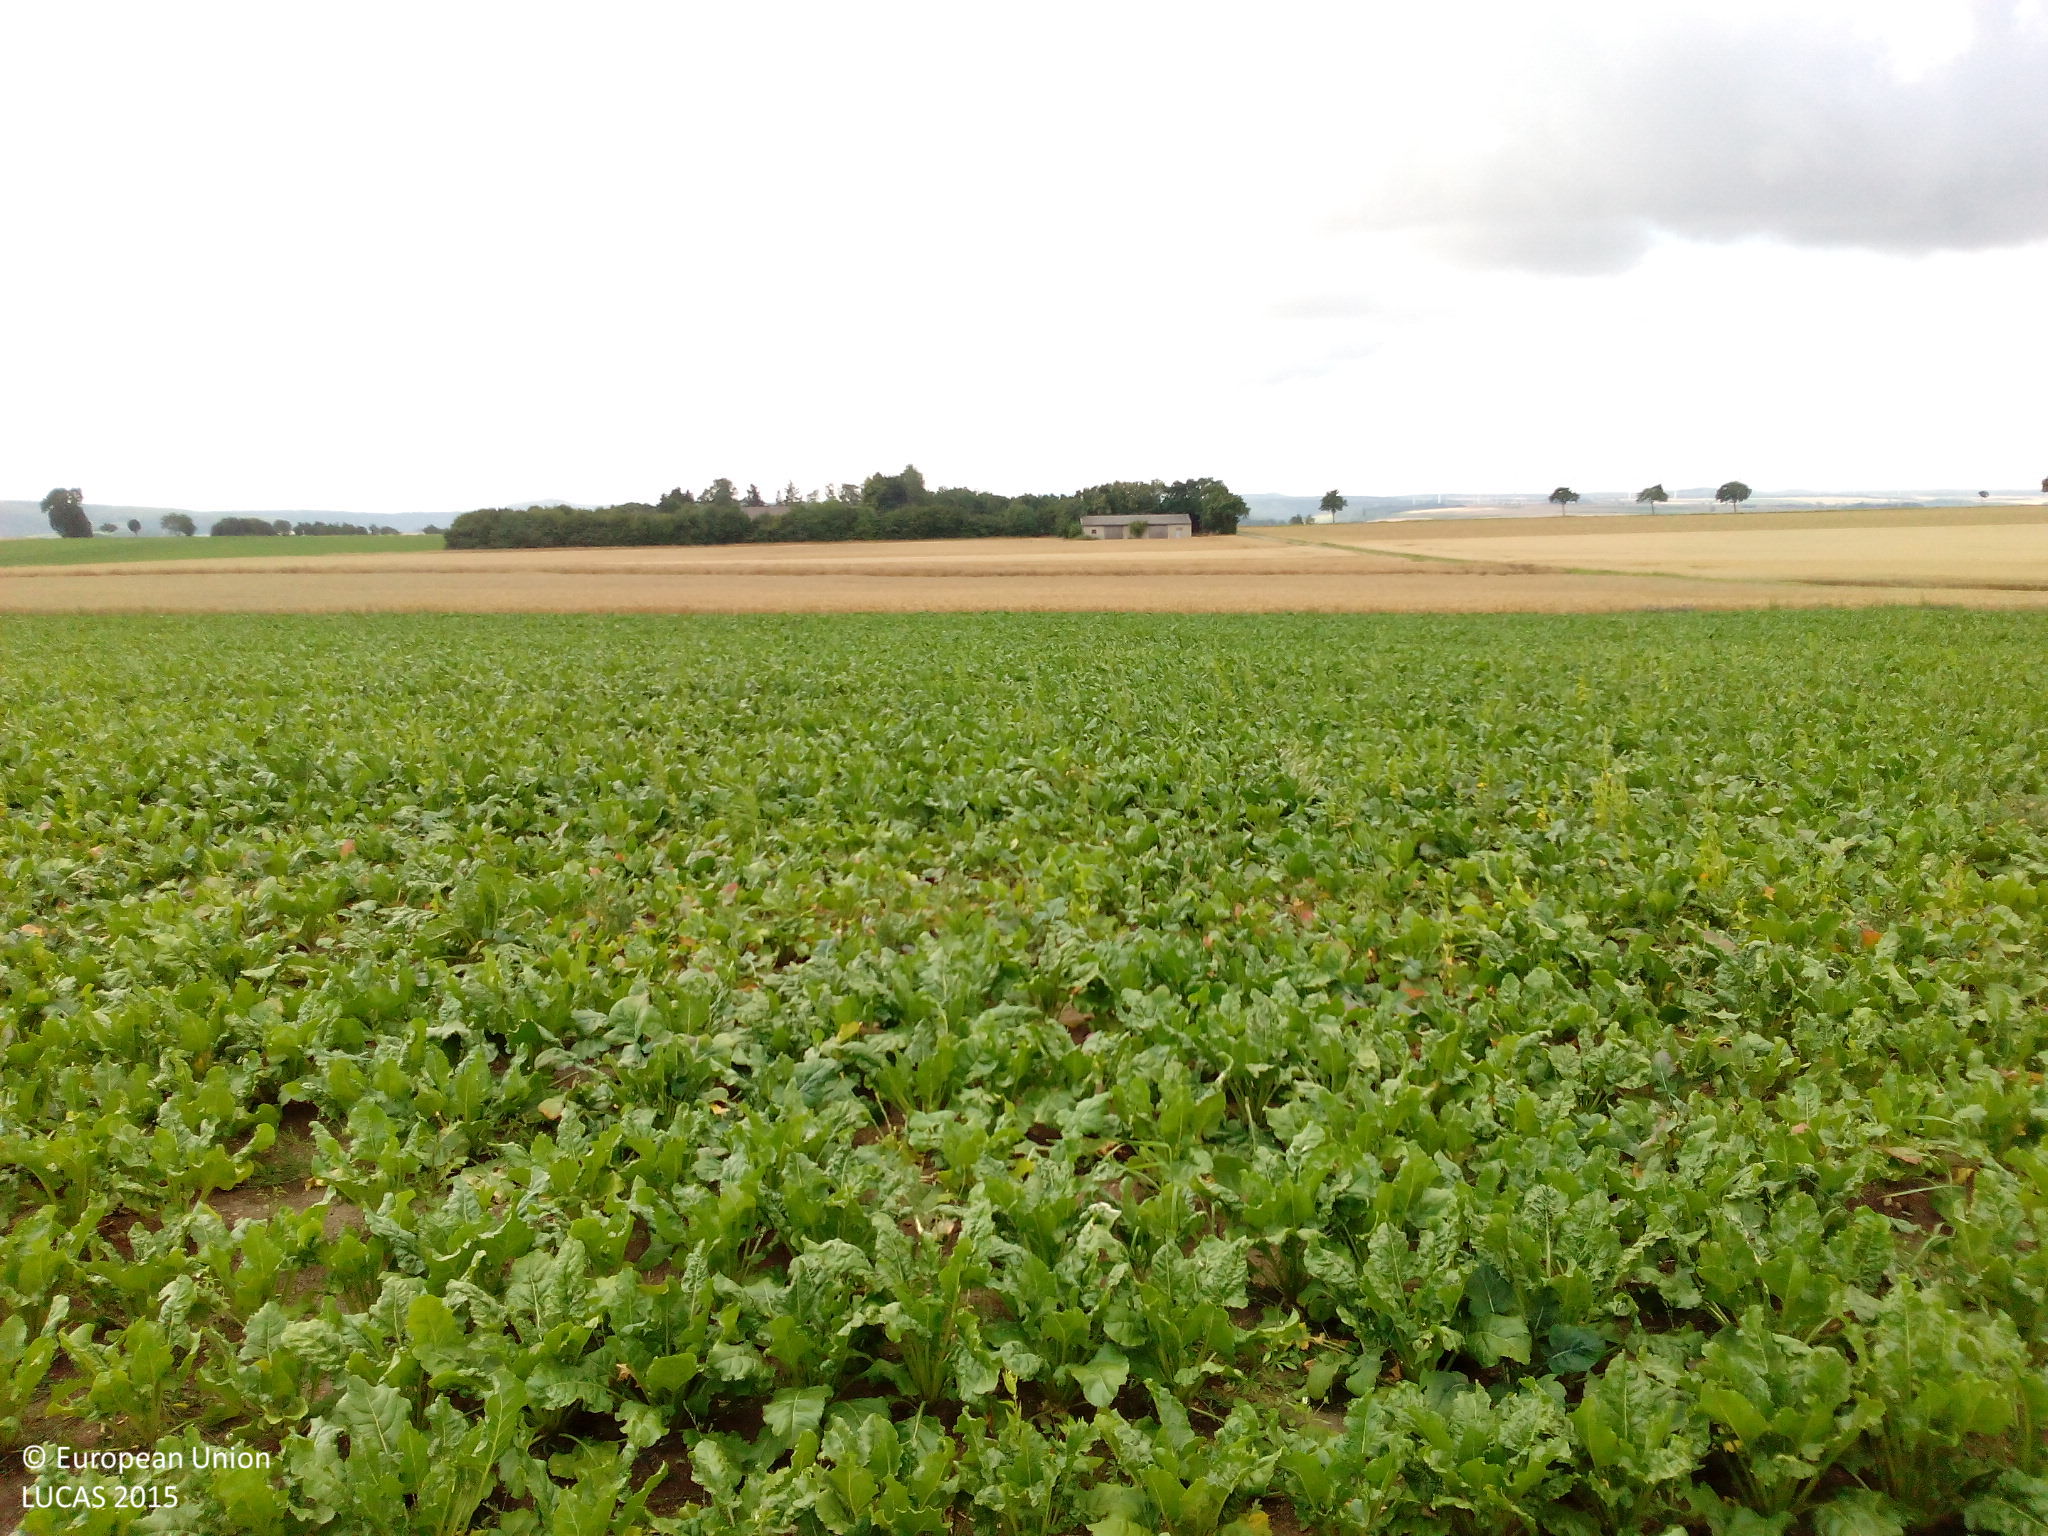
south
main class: Cropland
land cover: Sugar beet
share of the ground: > 75 %
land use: Agriculture (excluding fallow land and kitchen gardens)
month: July
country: DE
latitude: 51.5665
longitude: 9.2933
